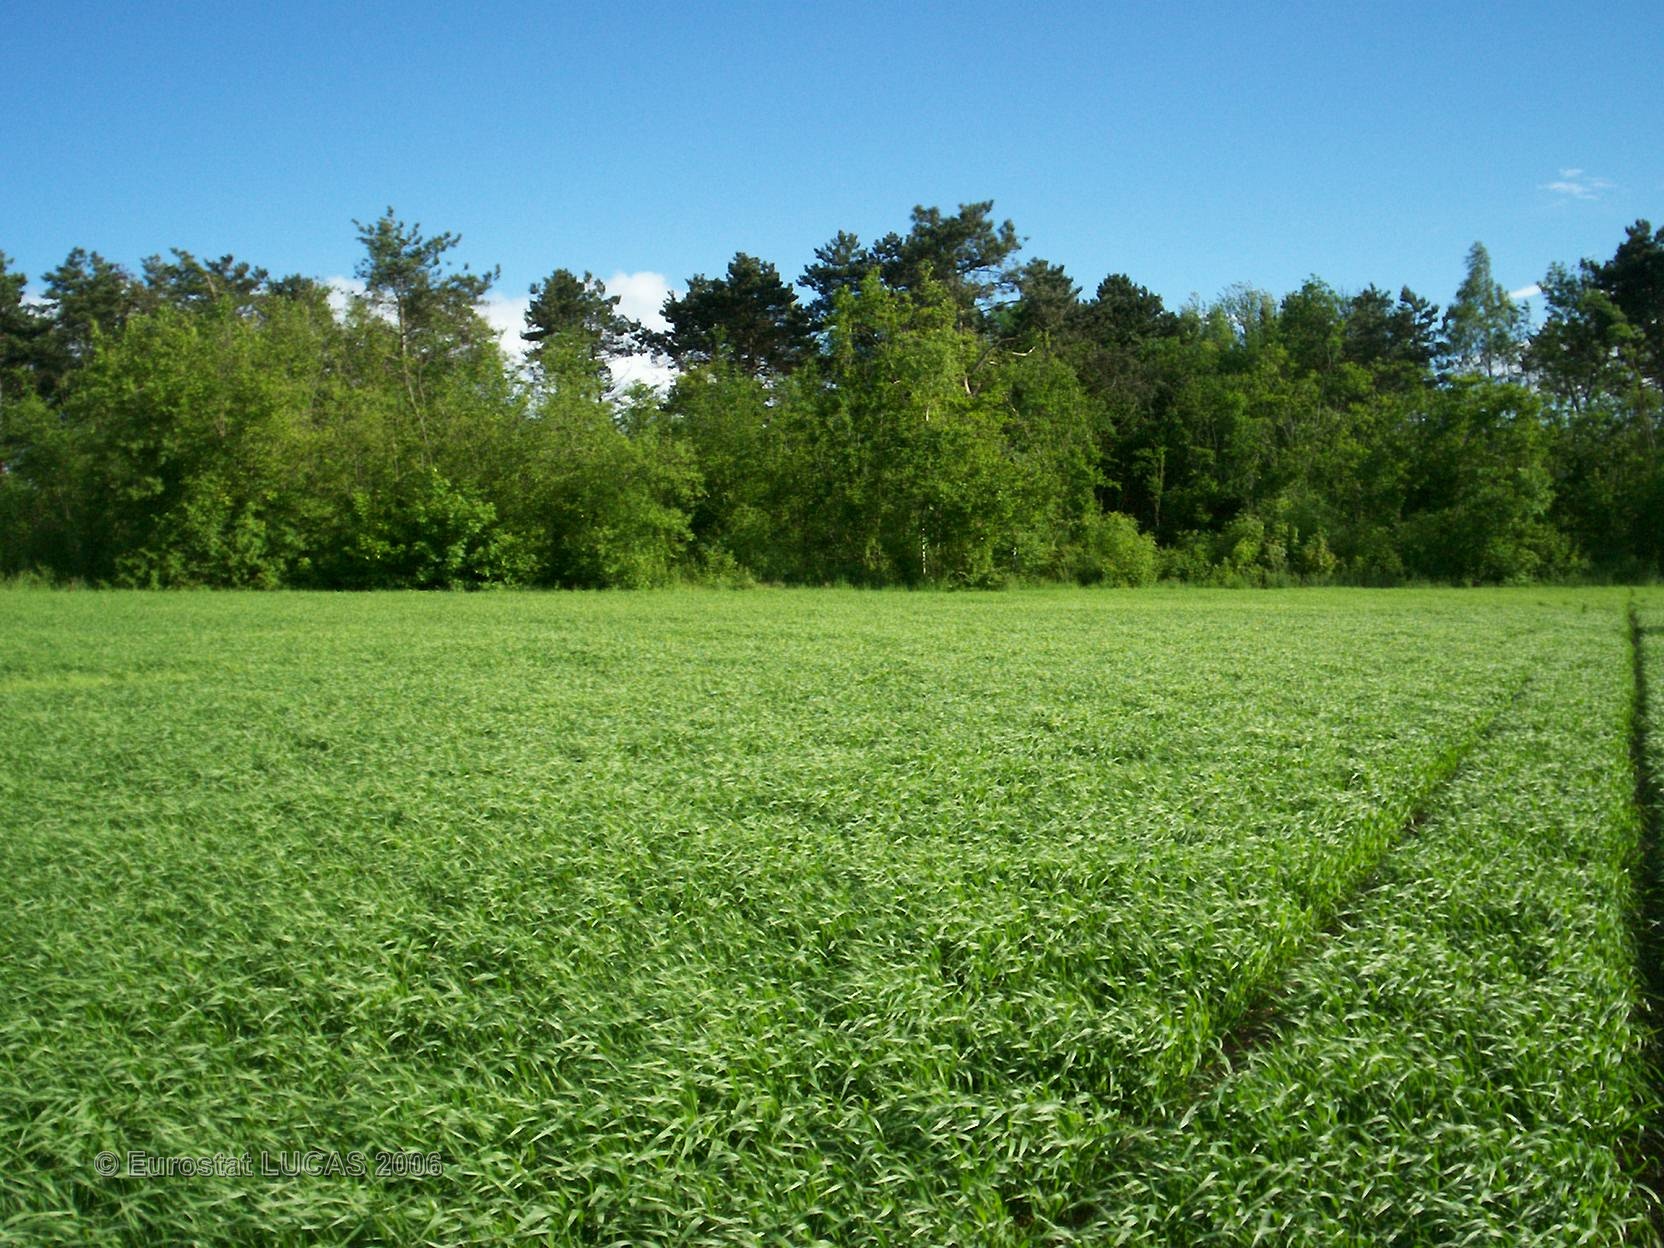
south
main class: Cropland
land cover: Barley
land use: Agriculture (excluding fallow land and kitchen gardens)
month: May
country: FR
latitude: 49.3886
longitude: 4.5823
